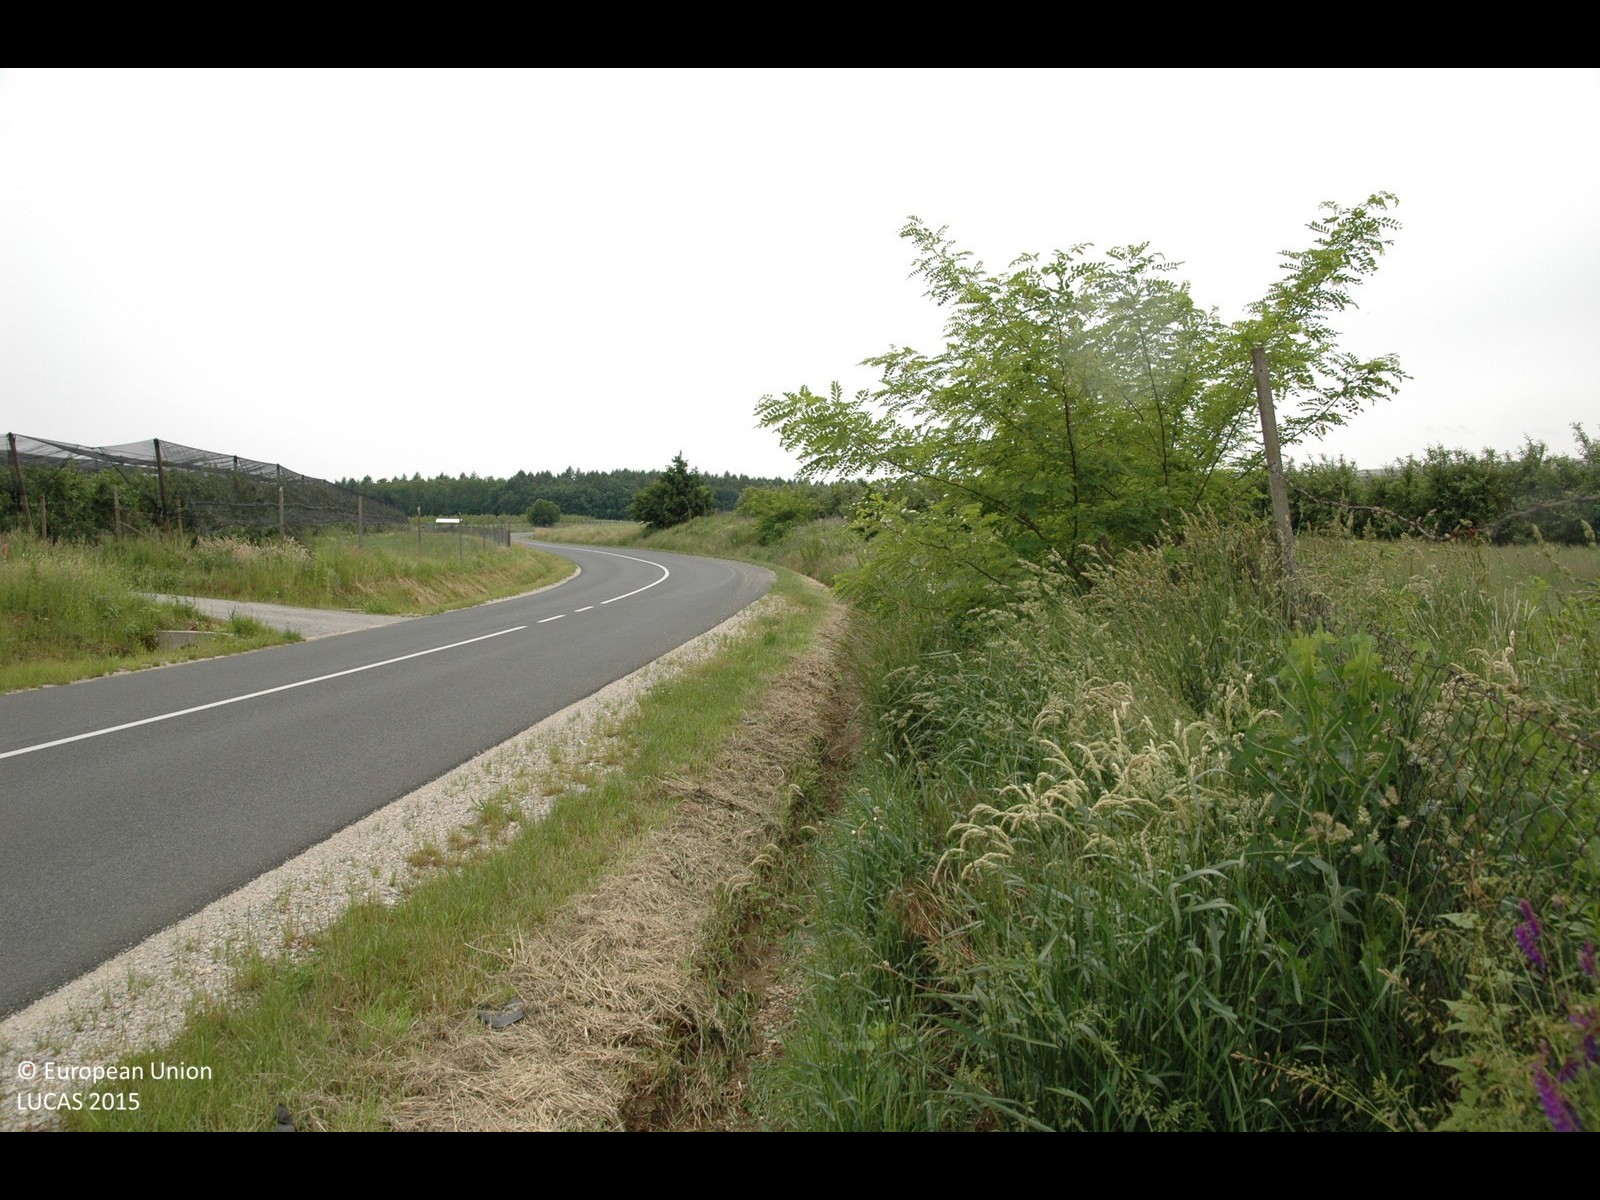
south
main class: Cropland
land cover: Apple fruit
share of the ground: 50 - 75 %
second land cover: Grassland without tree/shrub cover
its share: 50 - 75 %
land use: Agriculture (excluding fallow land and kitchen gardens)
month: May
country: HR
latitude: 46.4638
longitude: 16.4466
